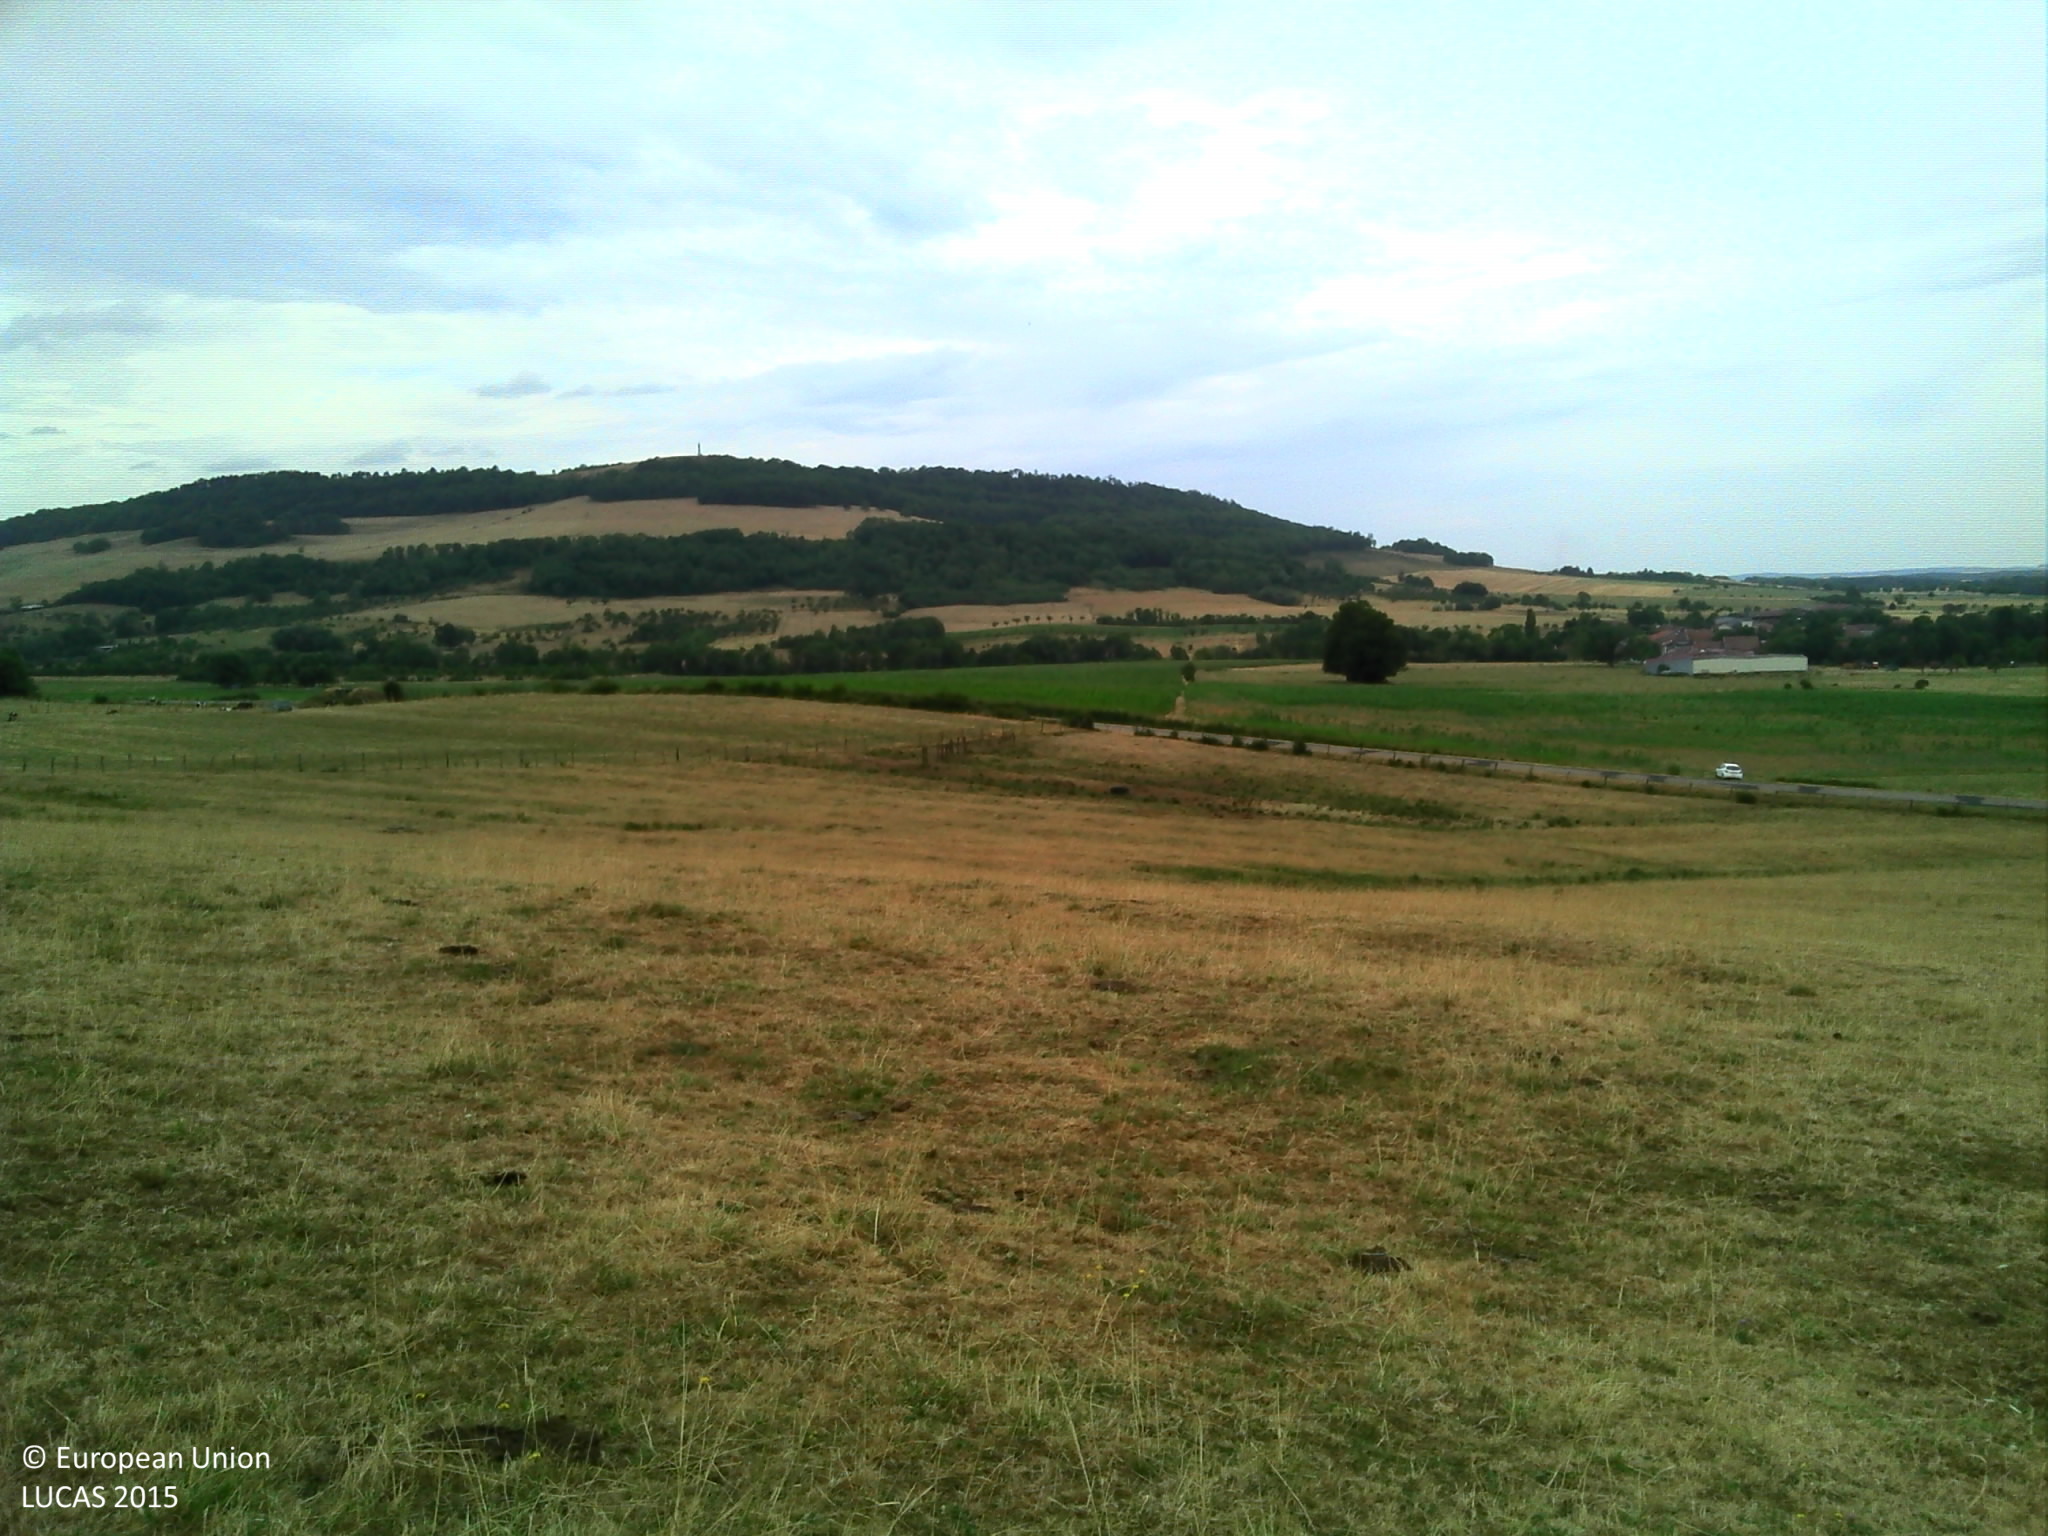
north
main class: Grassland
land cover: Grassland without tree/shrub cover
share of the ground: > 75 %
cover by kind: herbaceous plants 100 %
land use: Agriculture (excluding fallow land and kitchen gardens)
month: July
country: FR
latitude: 48.3877
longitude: 6.0705
